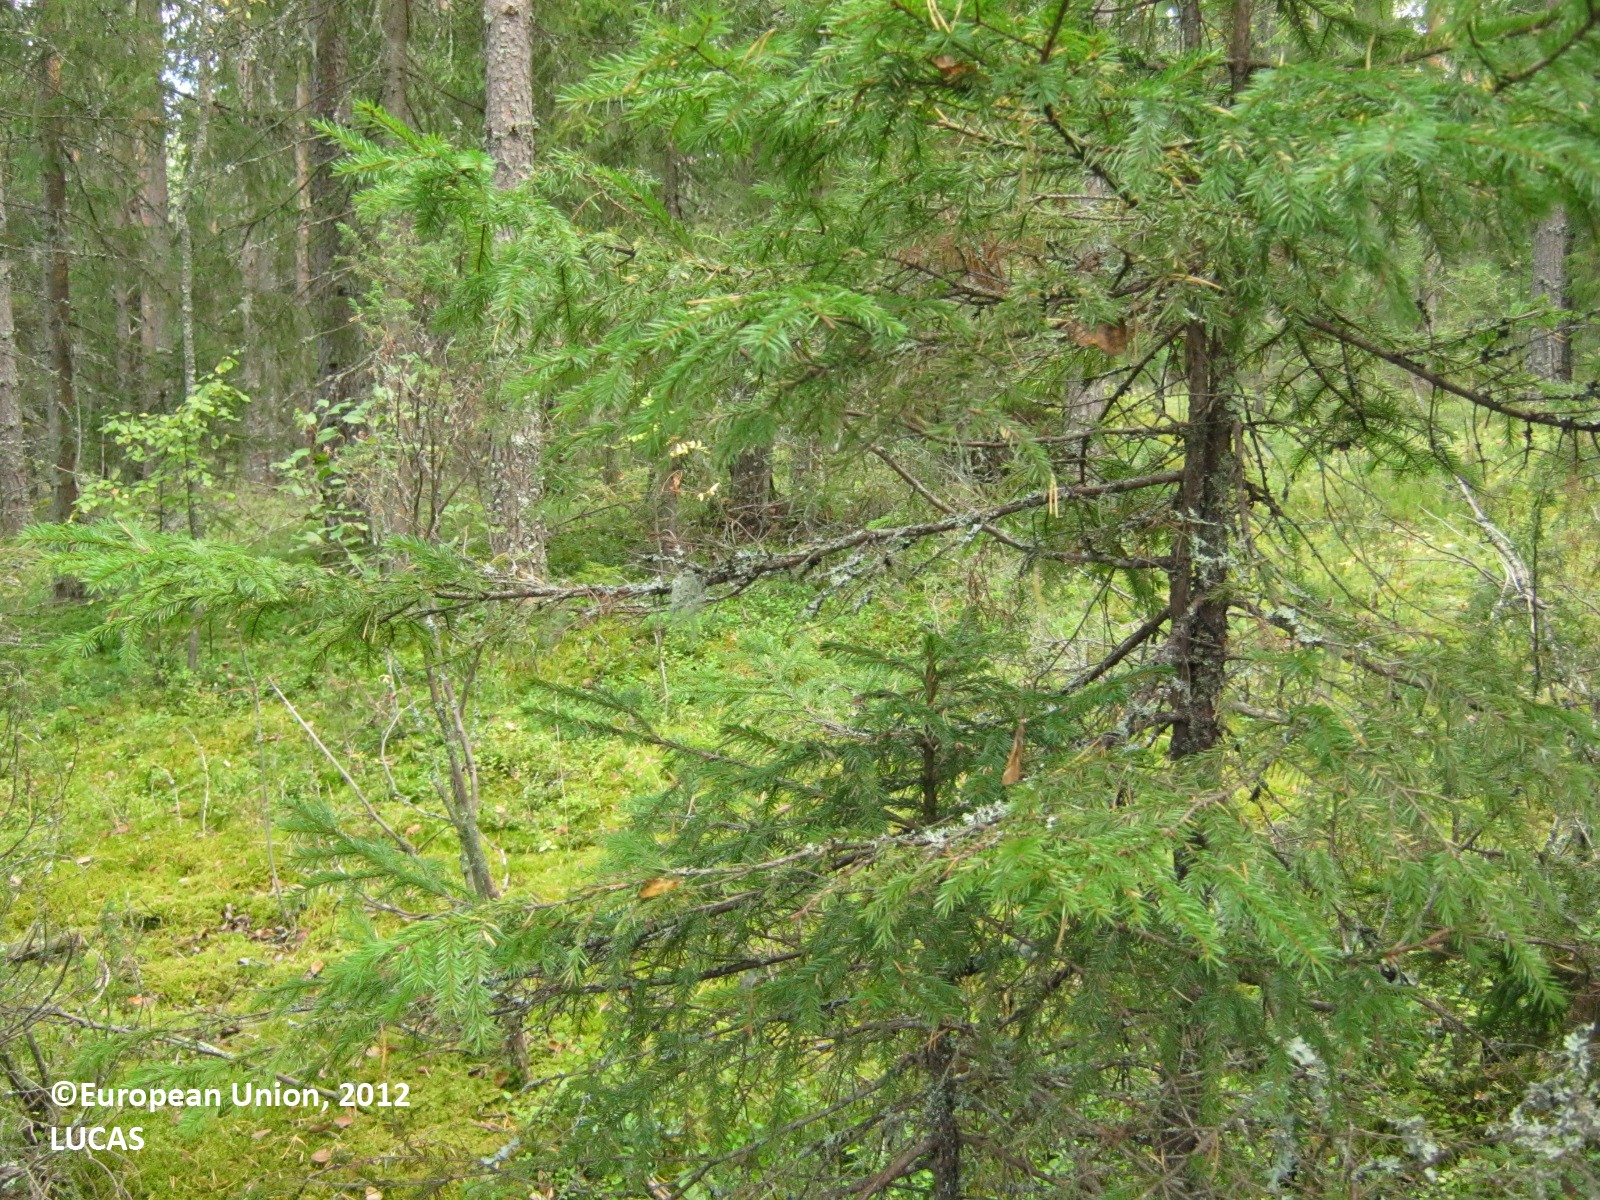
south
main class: Woodland
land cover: Other coniferous woodland
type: boreal forest
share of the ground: > 75 %
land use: Forestry
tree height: > 5 m
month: September
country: FI
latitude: 60.8925
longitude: 27.9067
